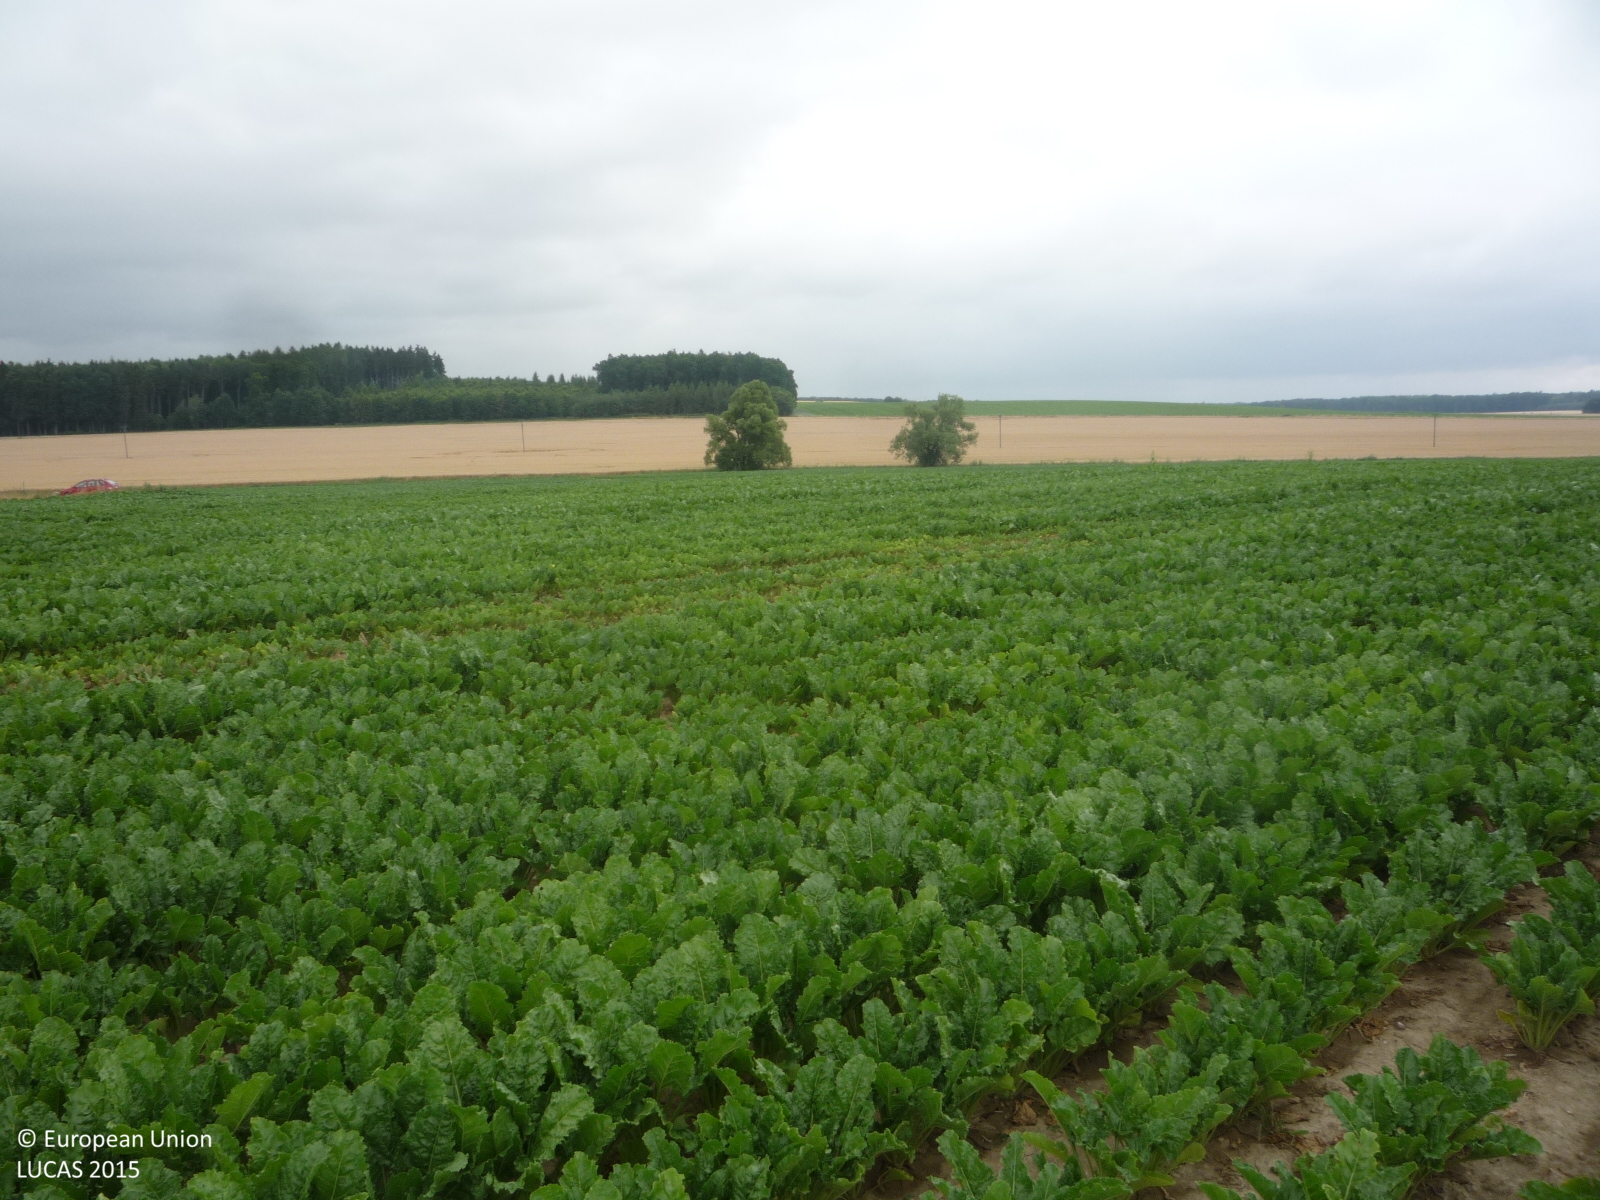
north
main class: Cropland
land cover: Sugar beet
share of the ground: > 75 %
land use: Agriculture (excluding fallow land and kitchen gardens)
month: July
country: CZ
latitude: 50.2050
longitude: 15.6791
